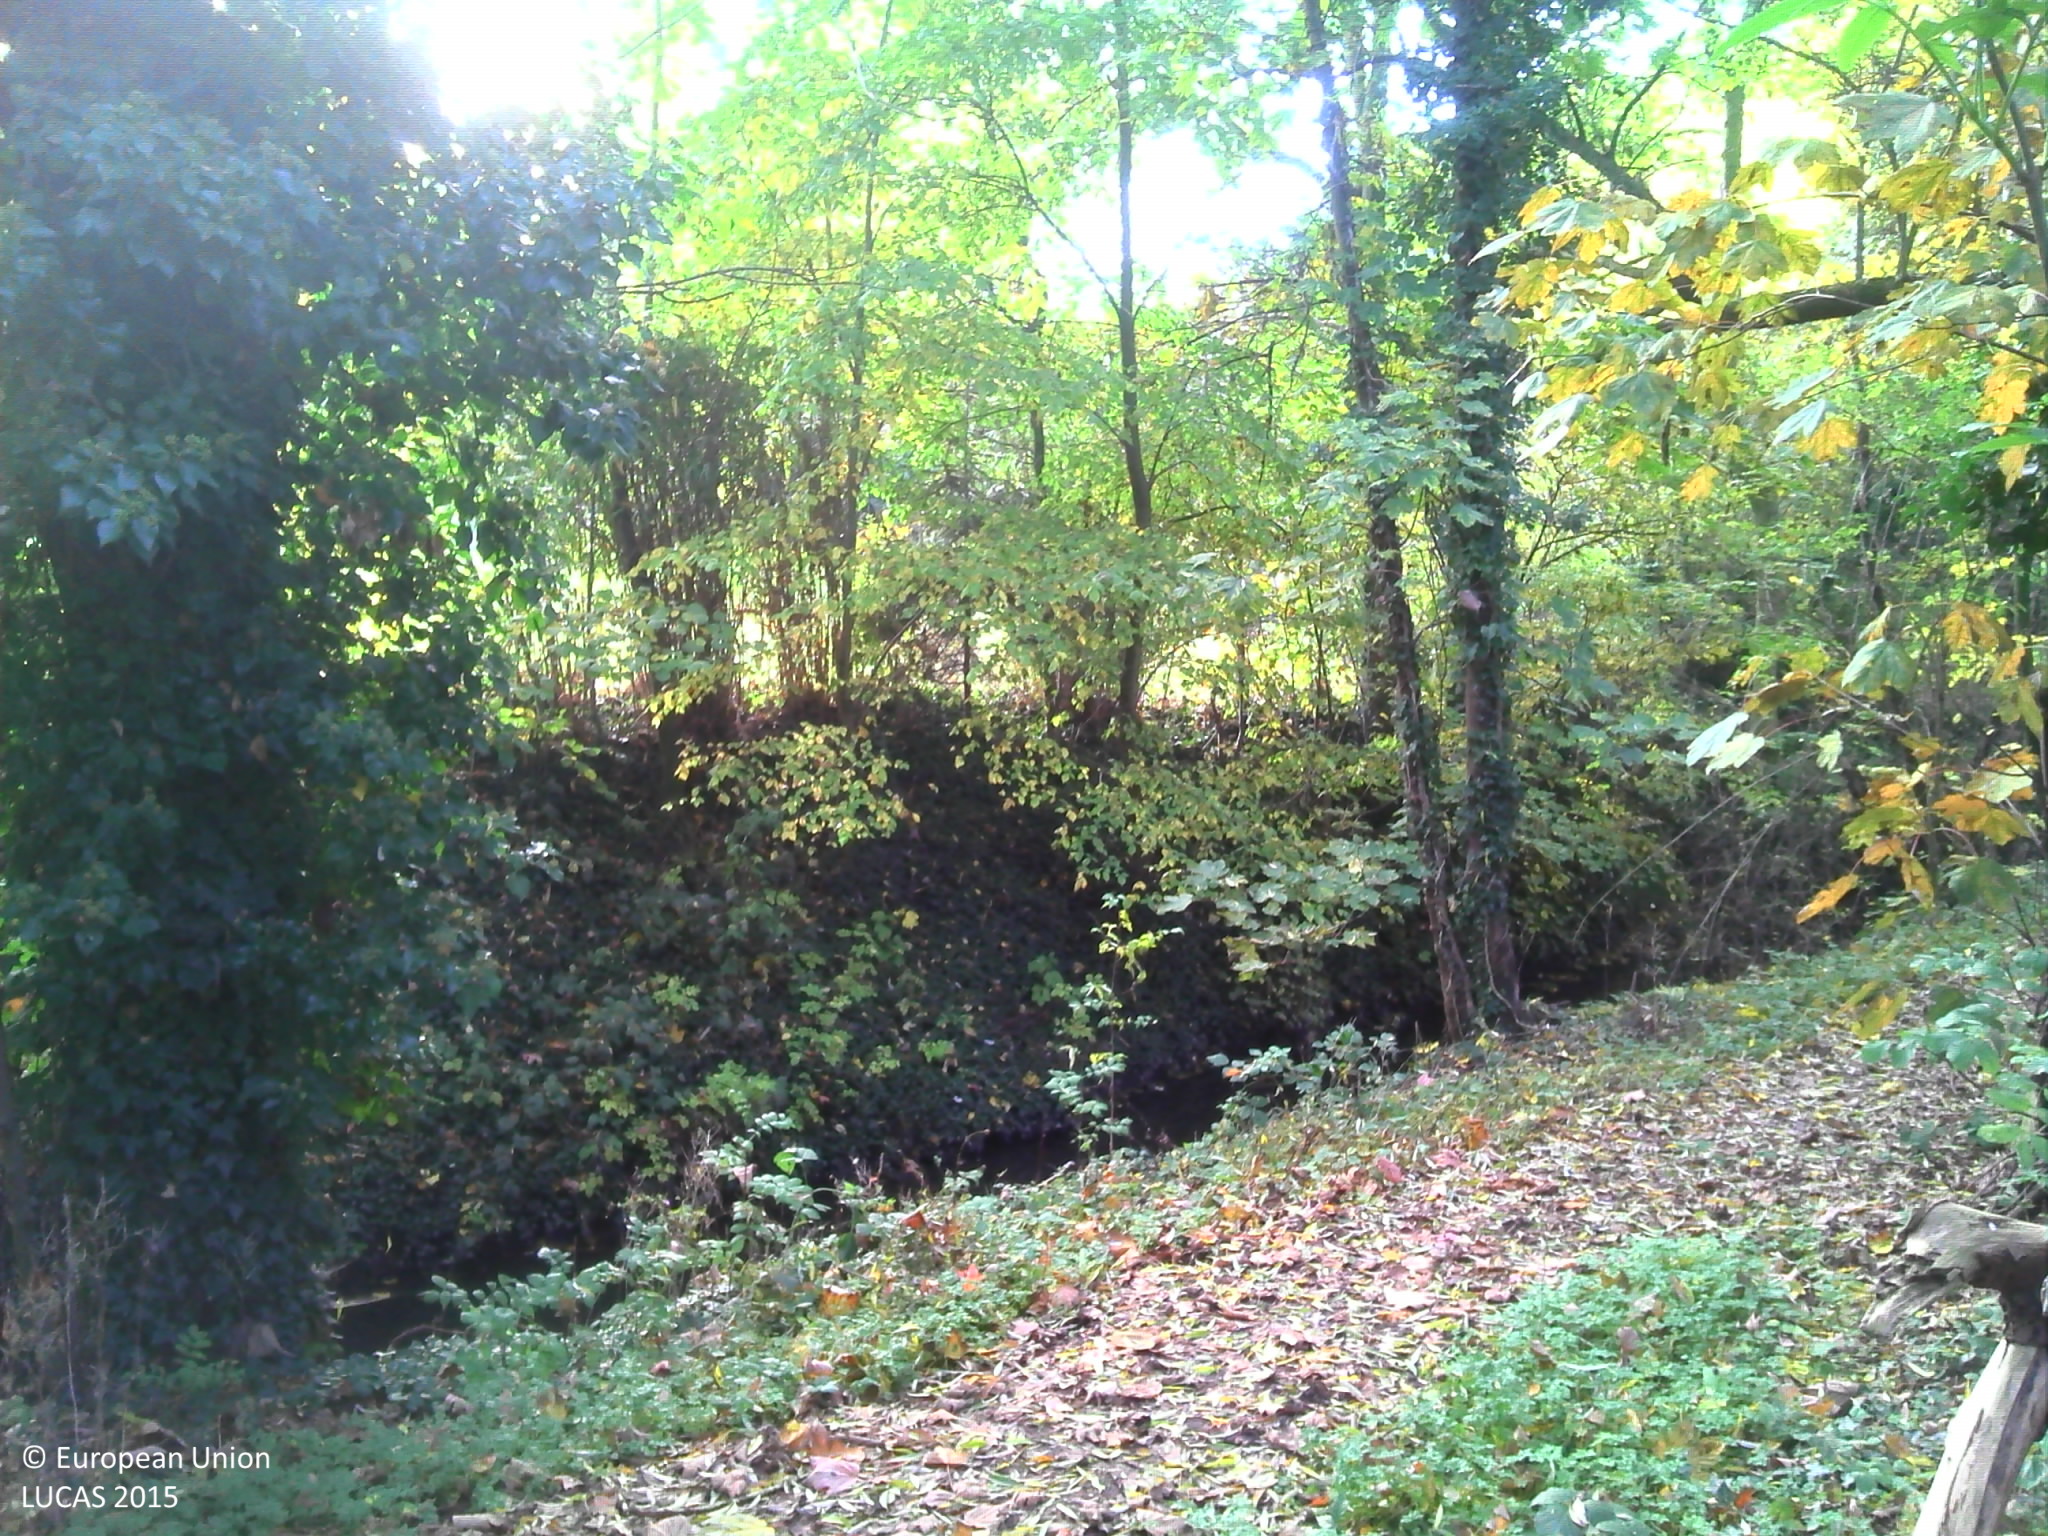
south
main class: Woodland
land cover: Broadleaved woodland
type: mesophytic deciduous forest
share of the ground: > 75 %
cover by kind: broadleaved forest trees 90 %, shrubs 5 %, herbaceous plants 5 %
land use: Amenities, museums, leisure
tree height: > 5 m
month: October
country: BE
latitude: 50.8790
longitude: 4.4669
